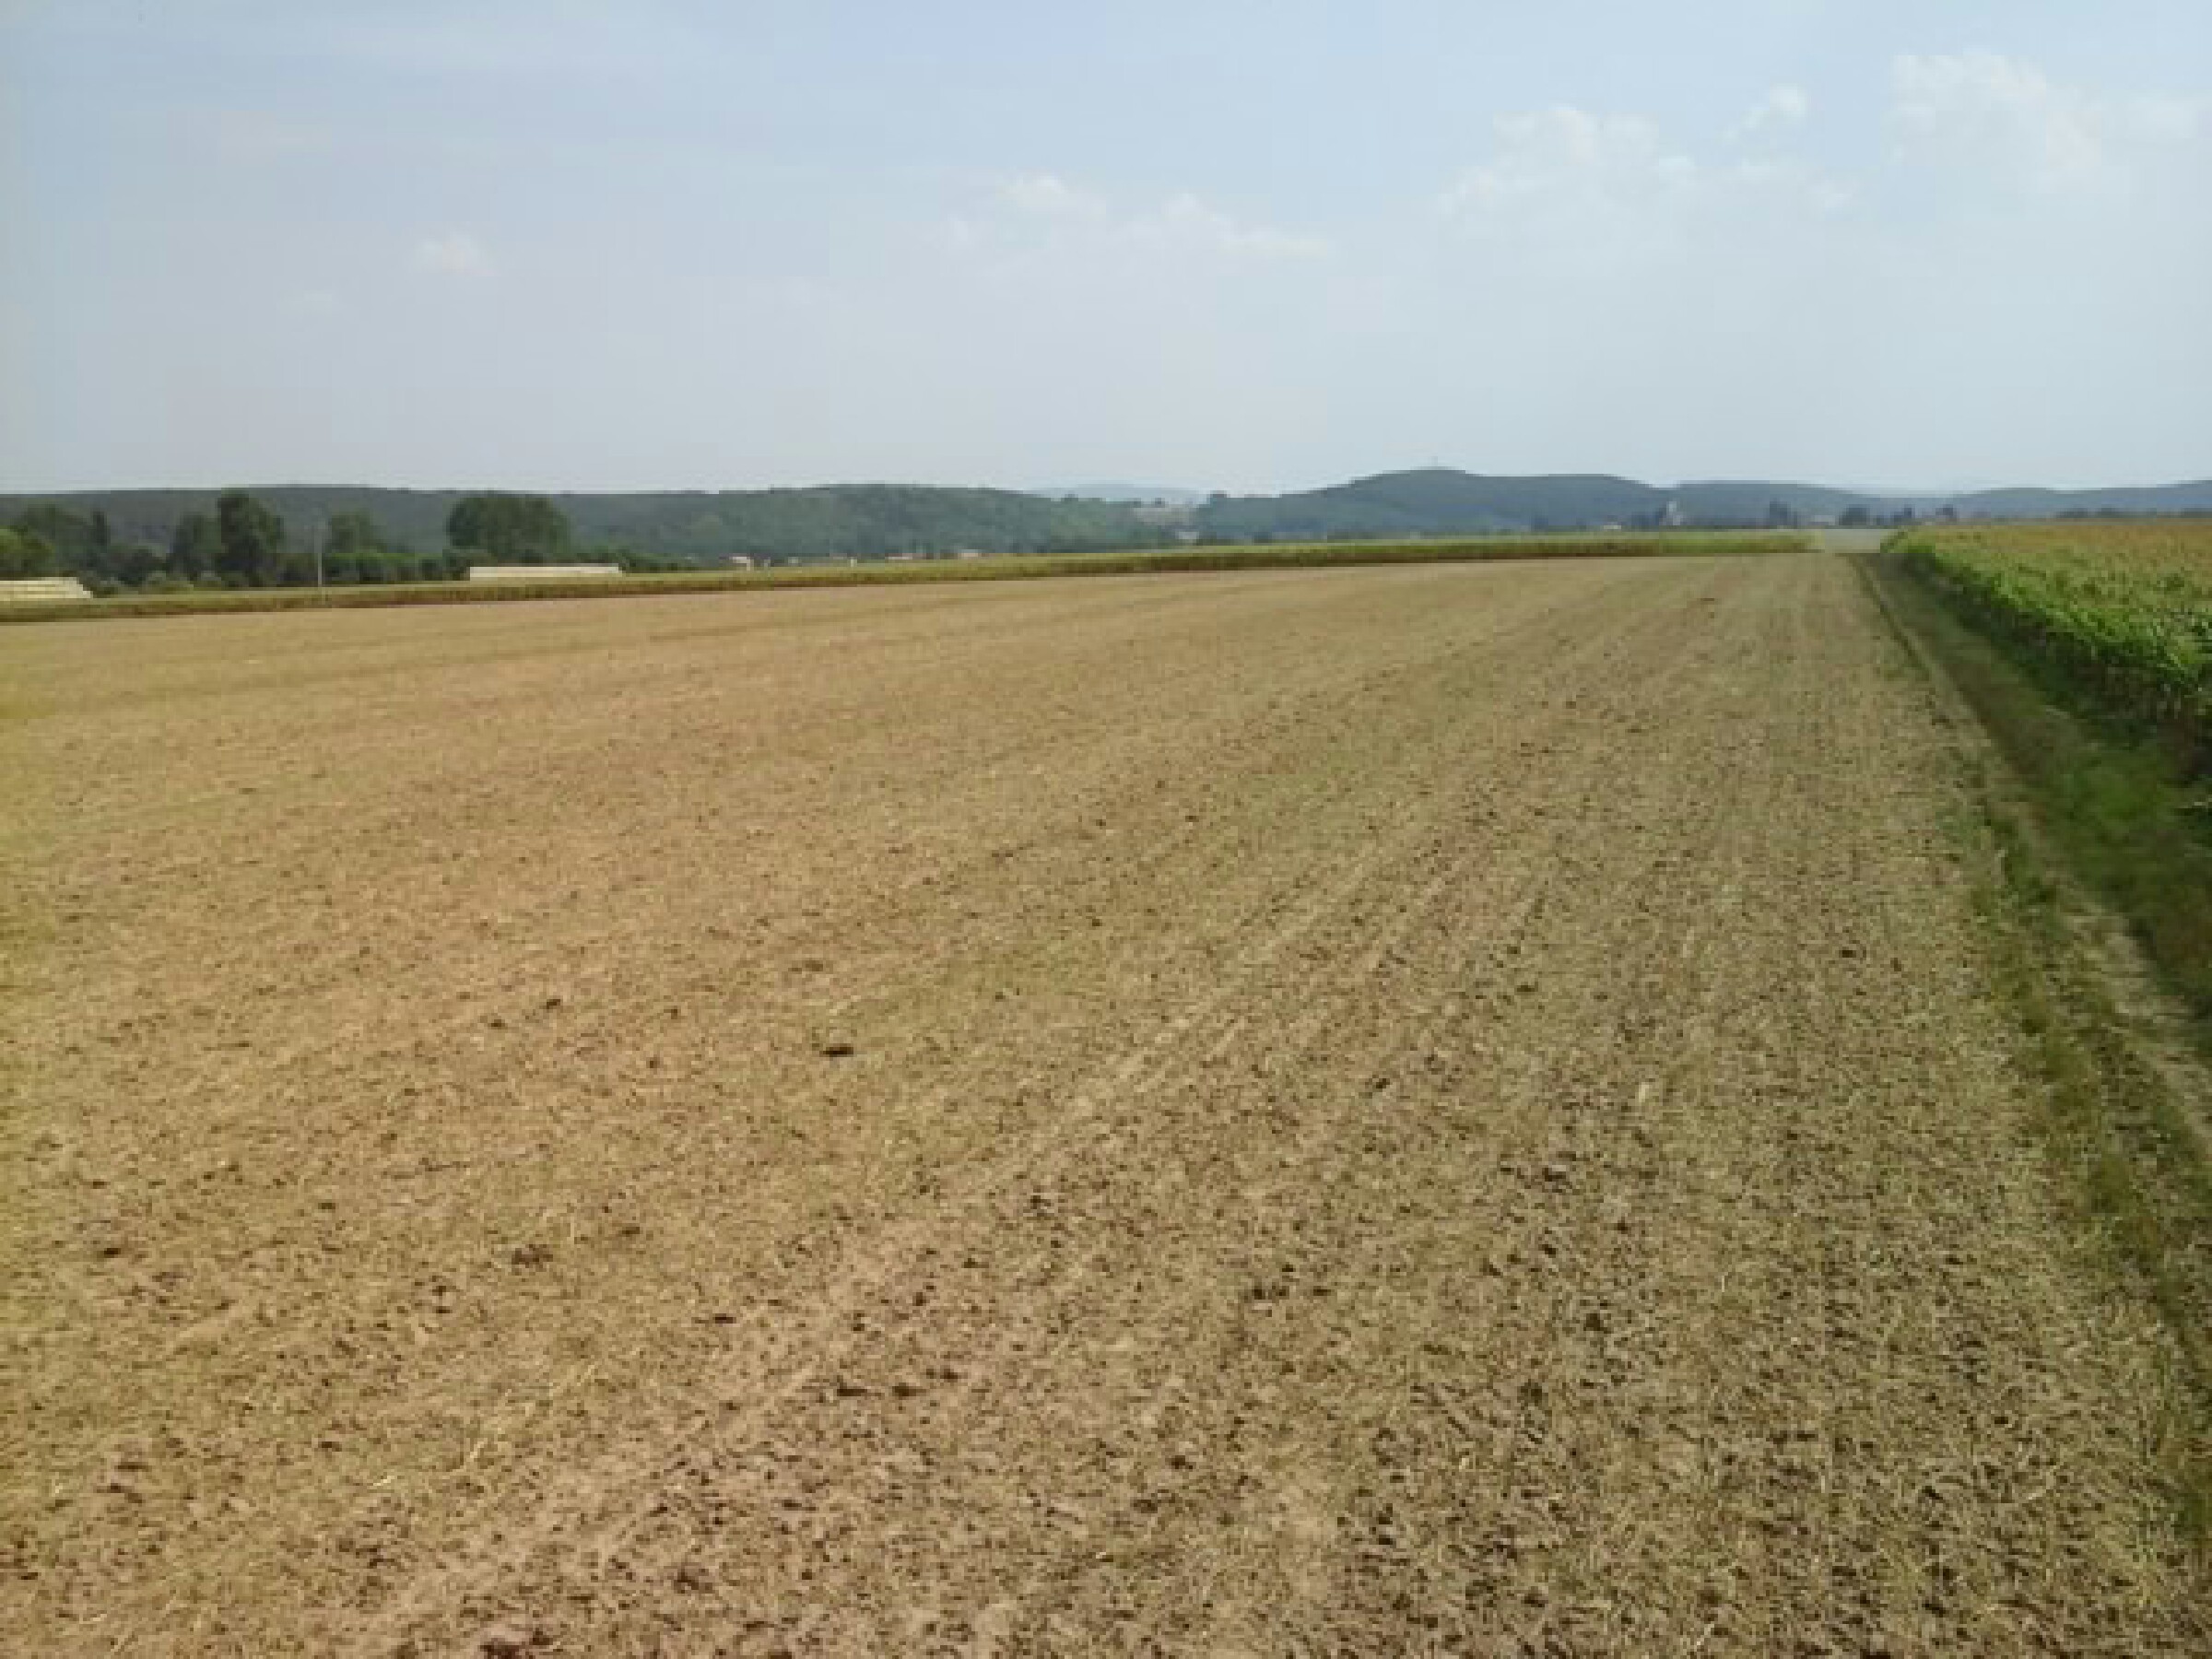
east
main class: Cropland
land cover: Maize
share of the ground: > 75 %
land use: Agriculture (excluding fallow land and kitchen gardens)
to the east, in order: Maize; Tracks; Common wheat
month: August
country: HU
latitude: 48.0255
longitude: 19.1251
